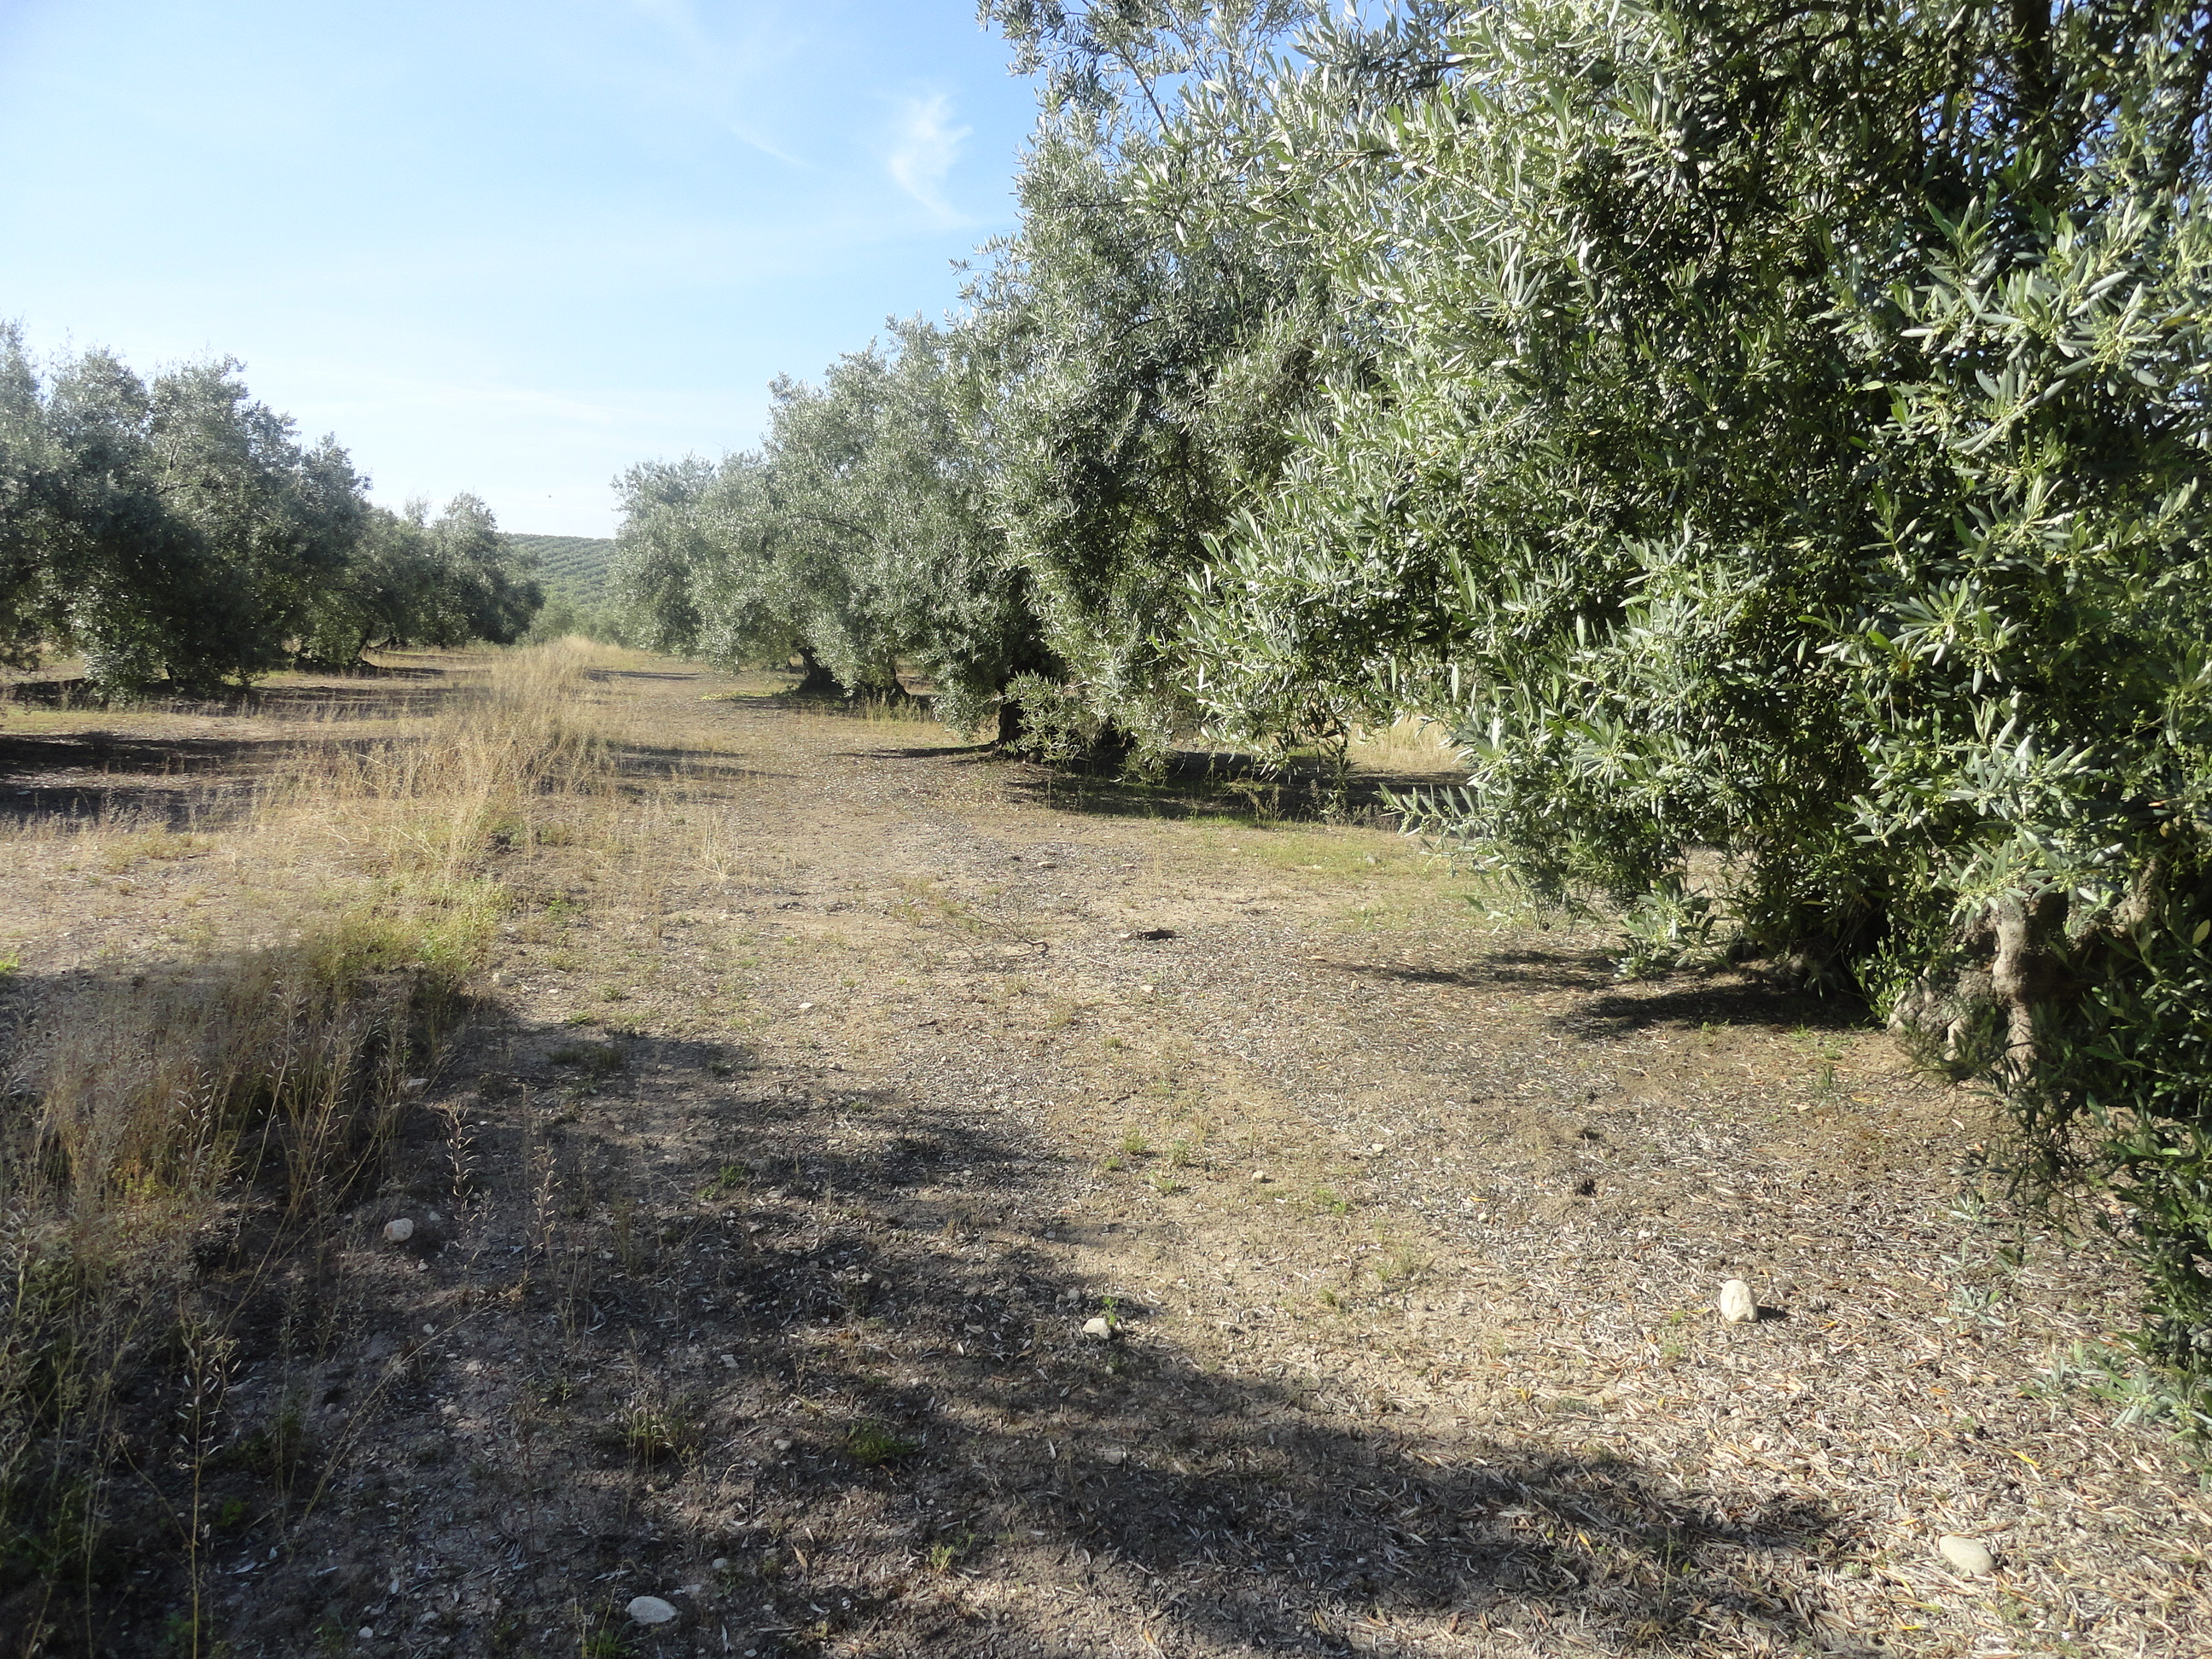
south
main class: Cropland
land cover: Olive groves
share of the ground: 50 - 75 %
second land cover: Spontaneously vegetated surfaces
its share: 25 - 50 %
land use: Agriculture (excluding fallow land and kitchen gardens)
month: April
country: ES
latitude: 37.6408
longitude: -4.5014
